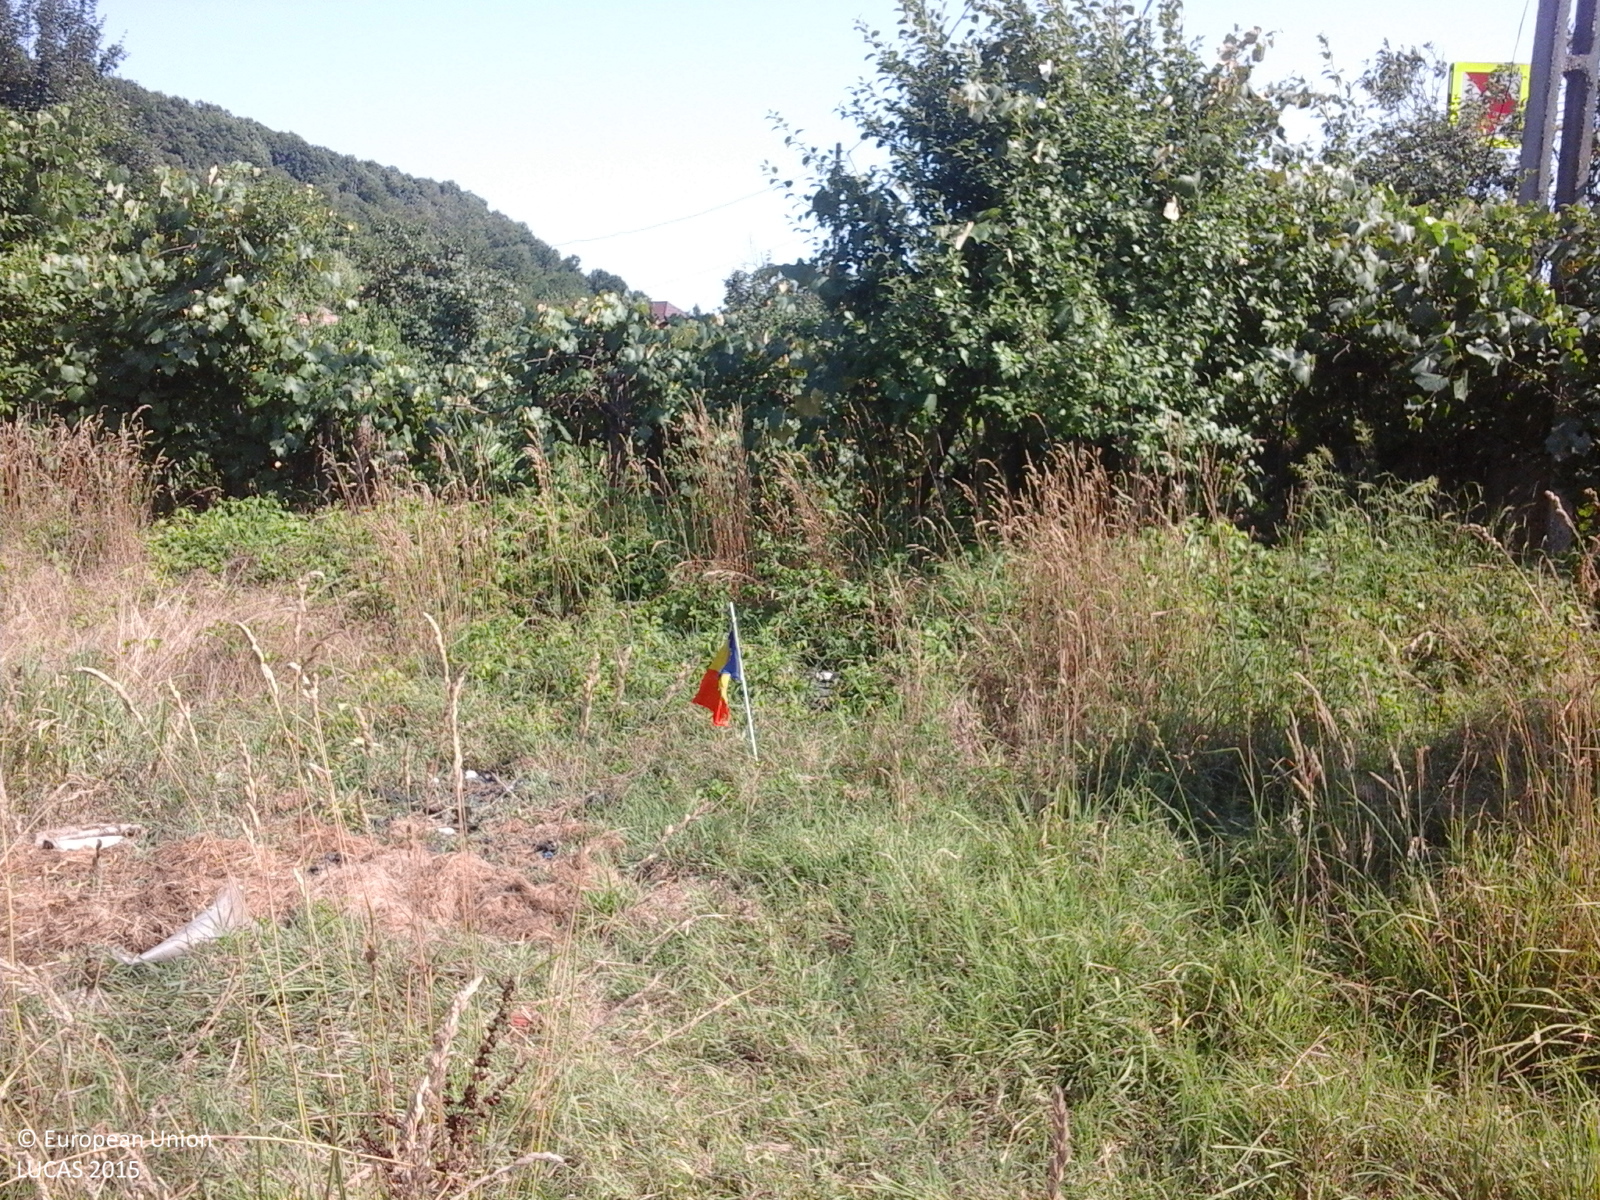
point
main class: Grassland
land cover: Spontaneously vegetated surfaces
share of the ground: > 75 %
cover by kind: herbaceous plants 100 %
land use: Agriculture (excluding fallow land and kitchen gardens)
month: July
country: RO
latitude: 45.0301
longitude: 24.4813
